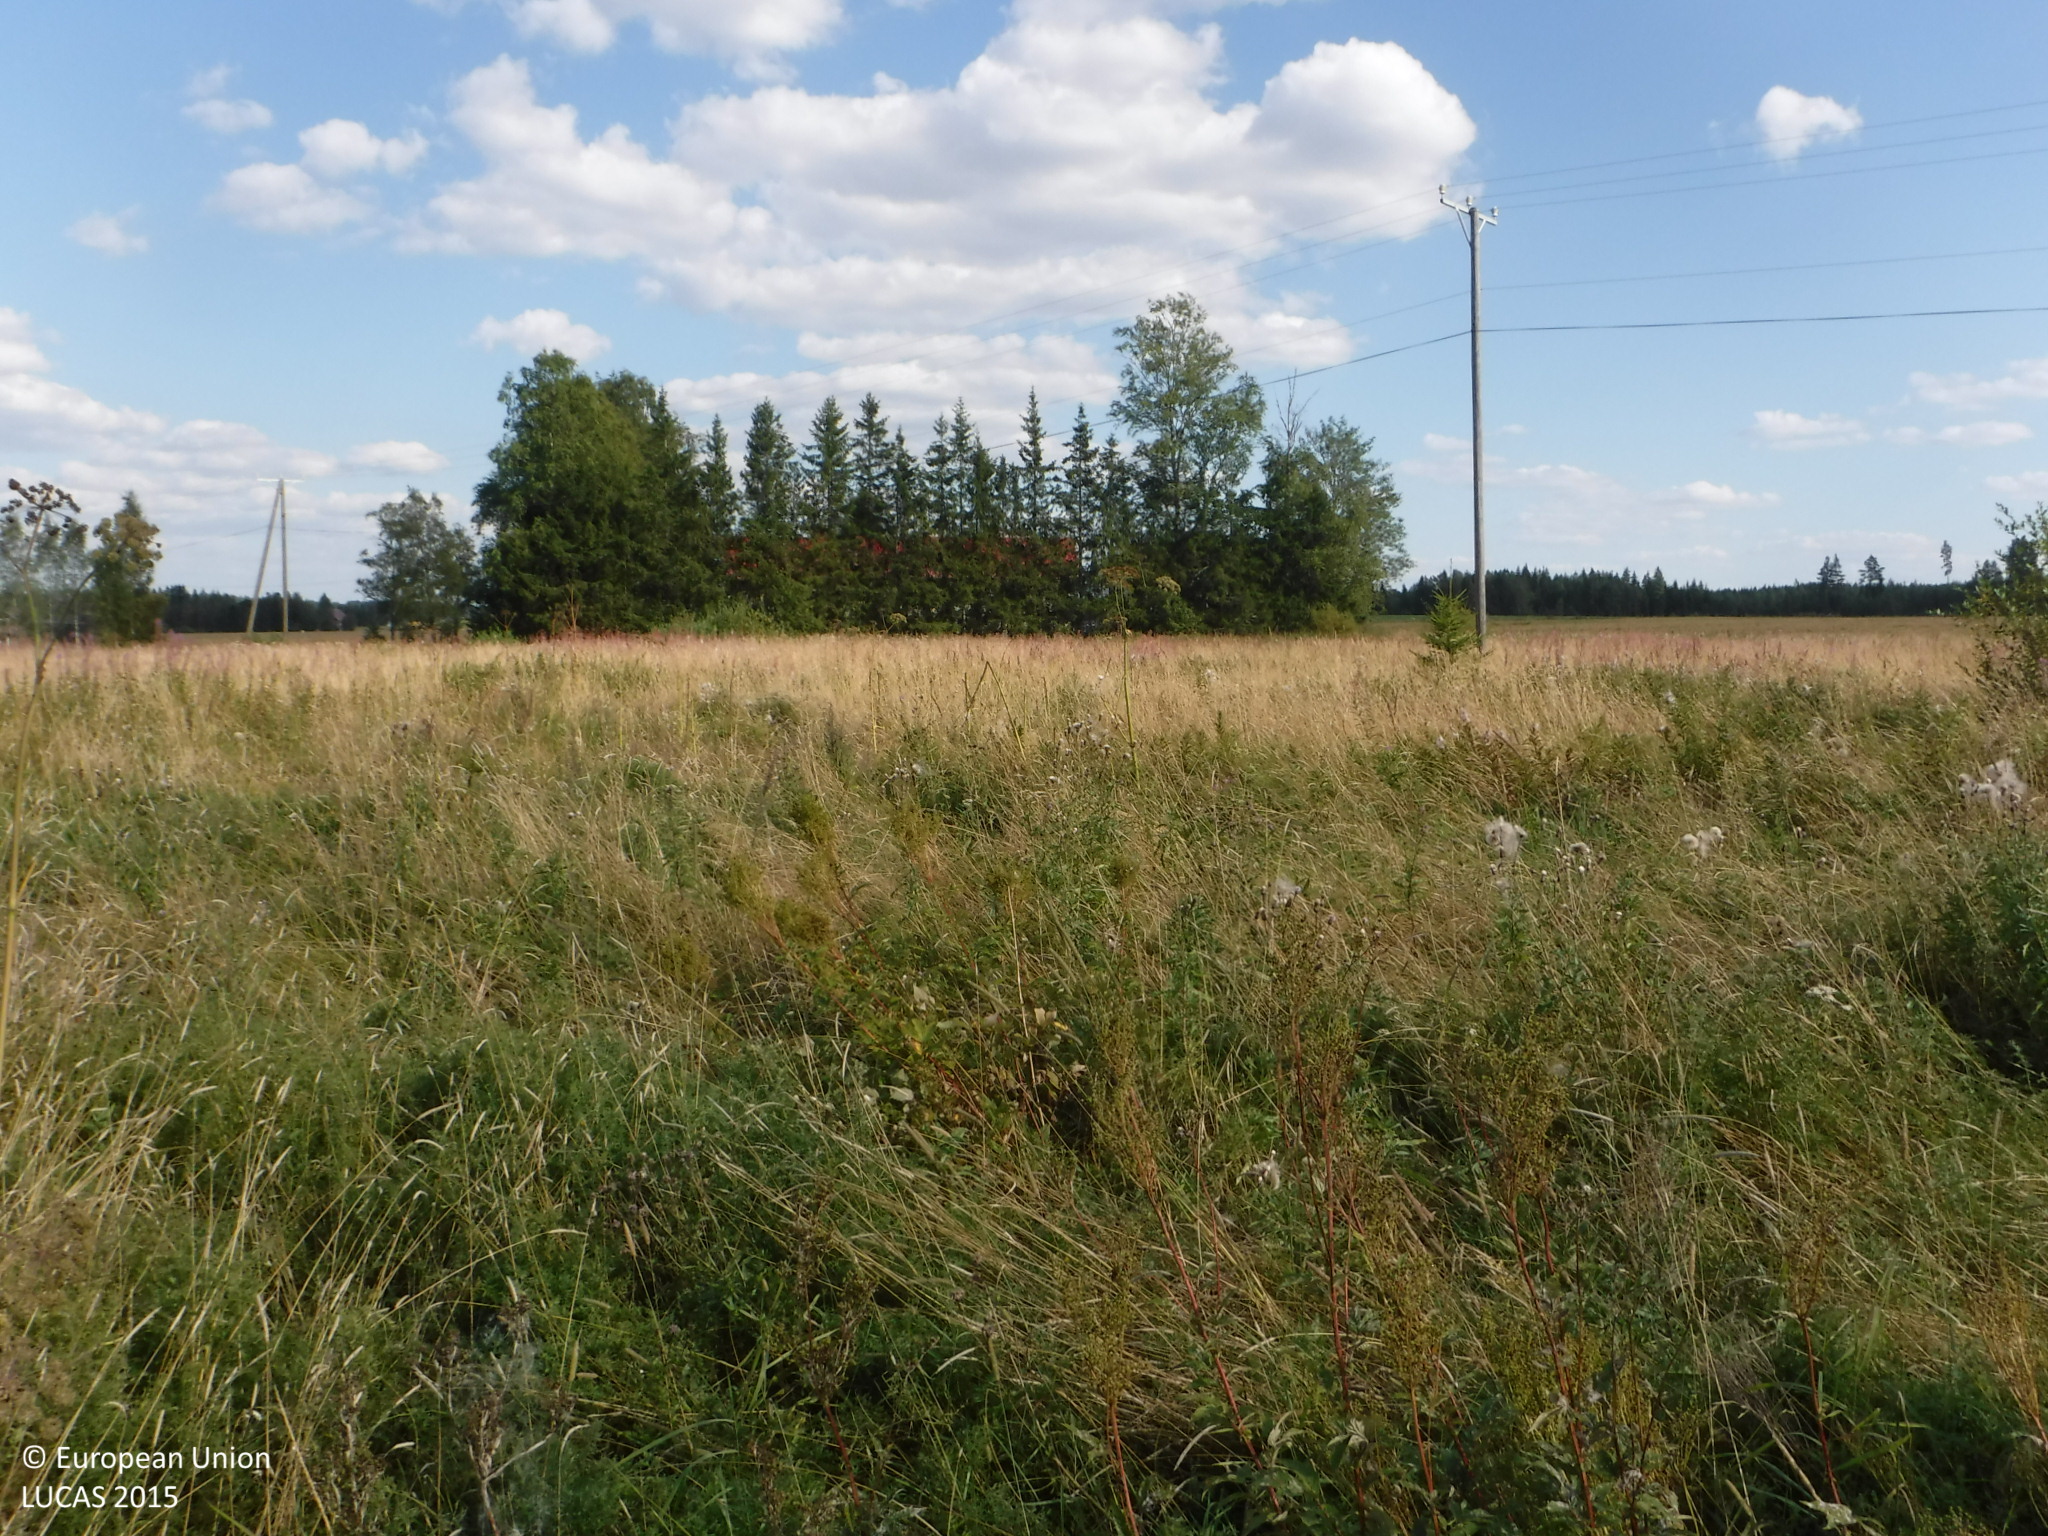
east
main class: Cropland
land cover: Barley
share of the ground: > 75 %
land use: Agriculture (excluding fallow land and kitchen gardens)
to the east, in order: Barley; Ditches and canals; Spontaneously vegetated surfaces; Electric lines; Spontaneously vegetated surfaces; Ditches and canals; Managed hedges; Artificial constructions in urban areas; Ditches and canals; Artificial constructions in urban areas; Ditches and canals; Other bare soil; Ditches and canals; Grass margins; Paved roads, cycling and walking lanes; Grass margins; Ditches and canals; Electric lines; Common wheat
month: August
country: FI
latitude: 61.1389
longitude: 22.9054
